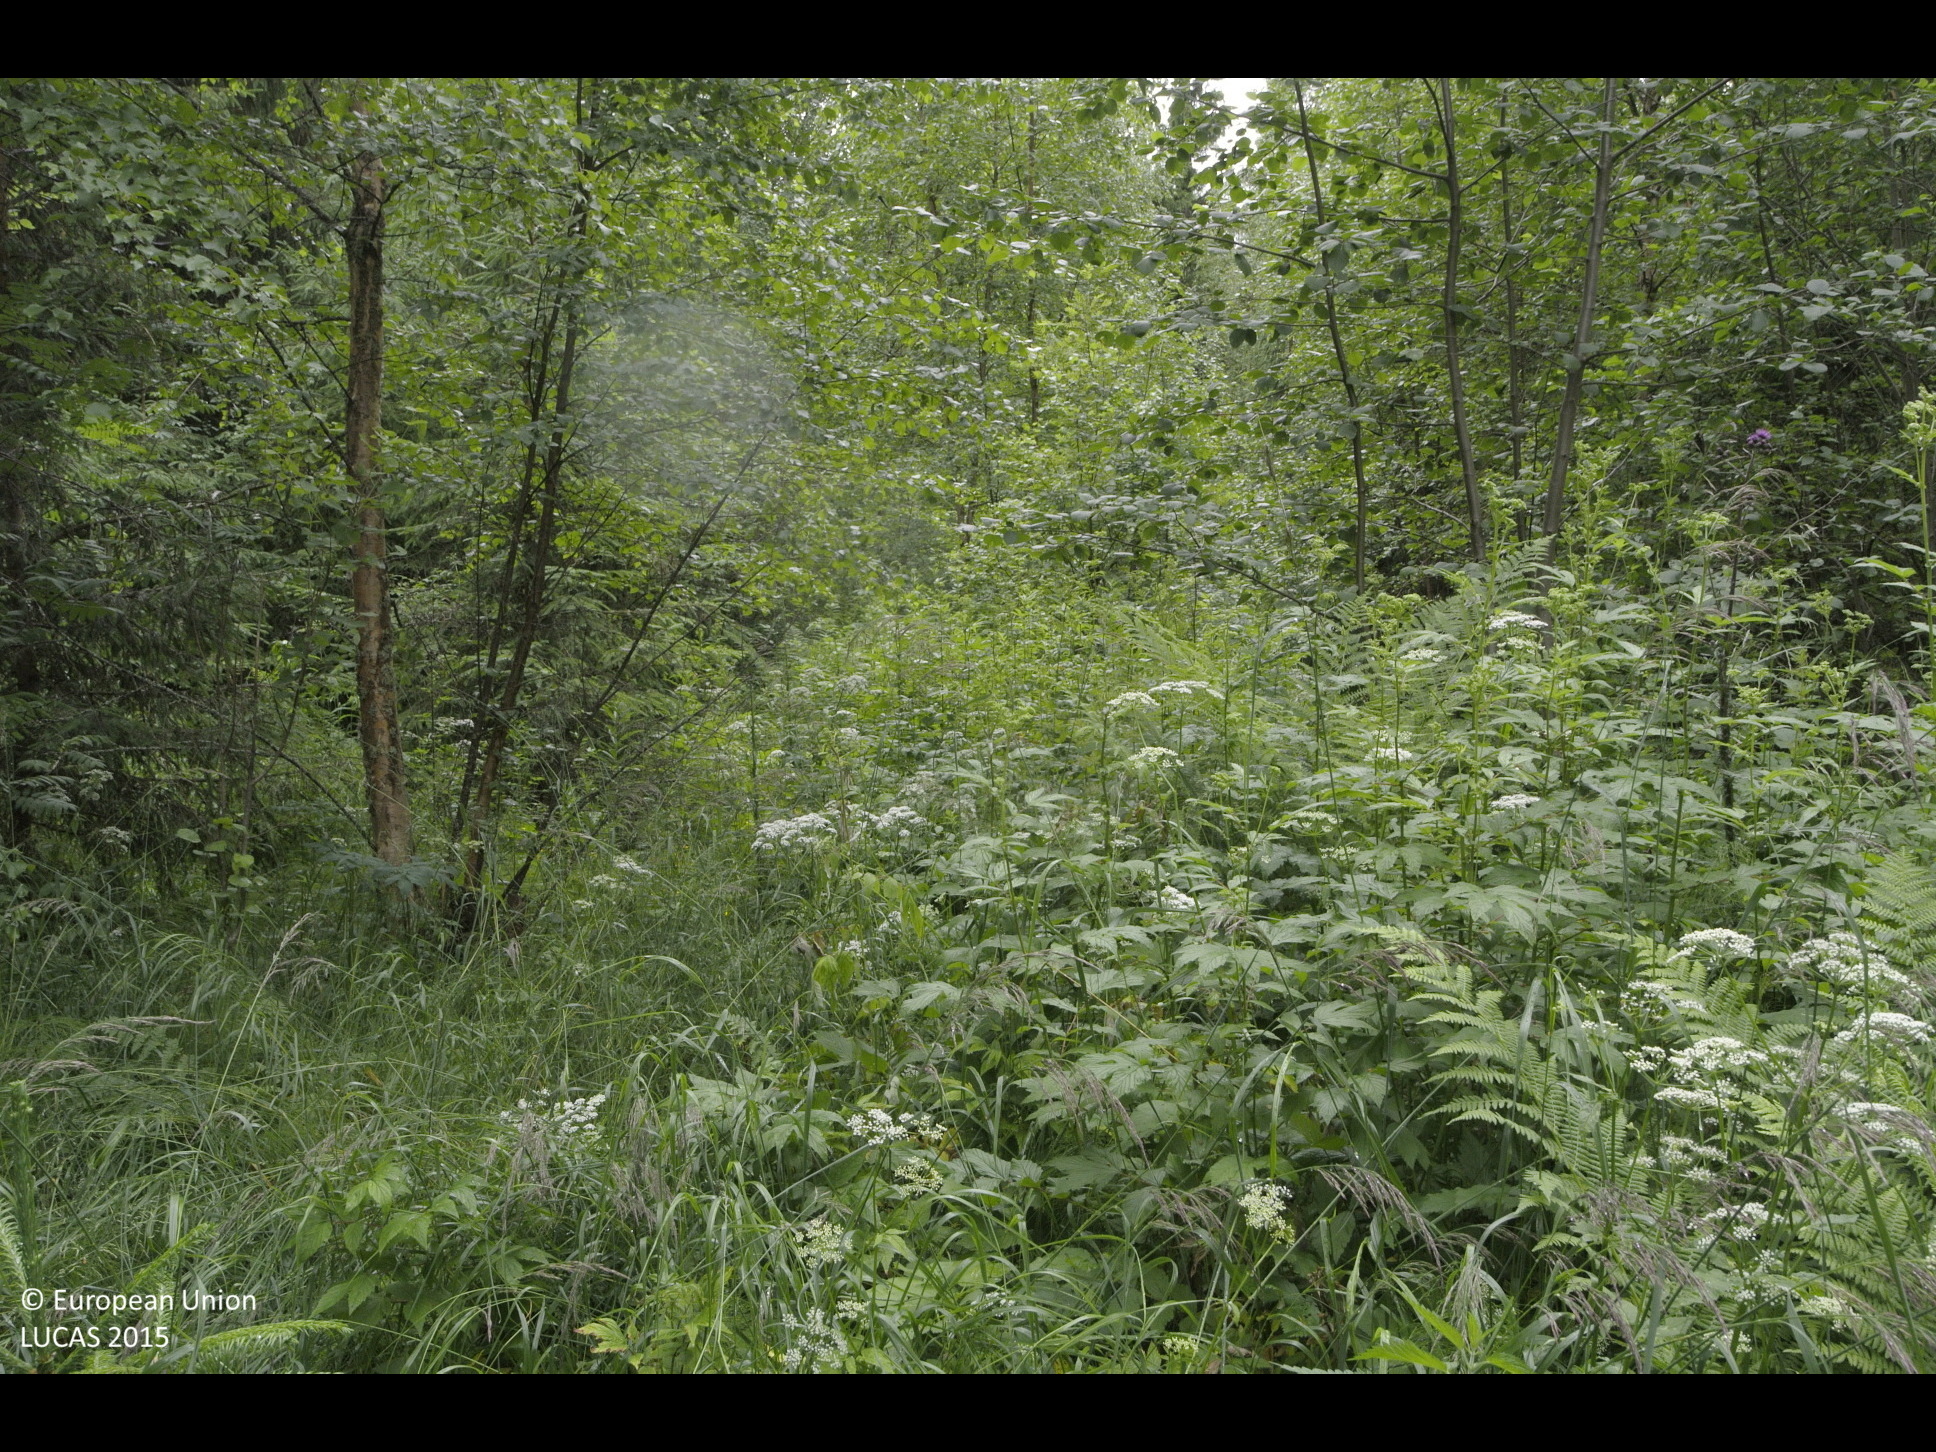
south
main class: Grassland
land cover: Grassland with sparse tree/shrub cover
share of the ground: > 75 %
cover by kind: herbaceous plants 90 %, coniferous forest trees 5 %, shrubs 5 %
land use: Semi-natural and natural areas not in use
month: July
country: FI
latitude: 61.5093
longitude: 25.8207
